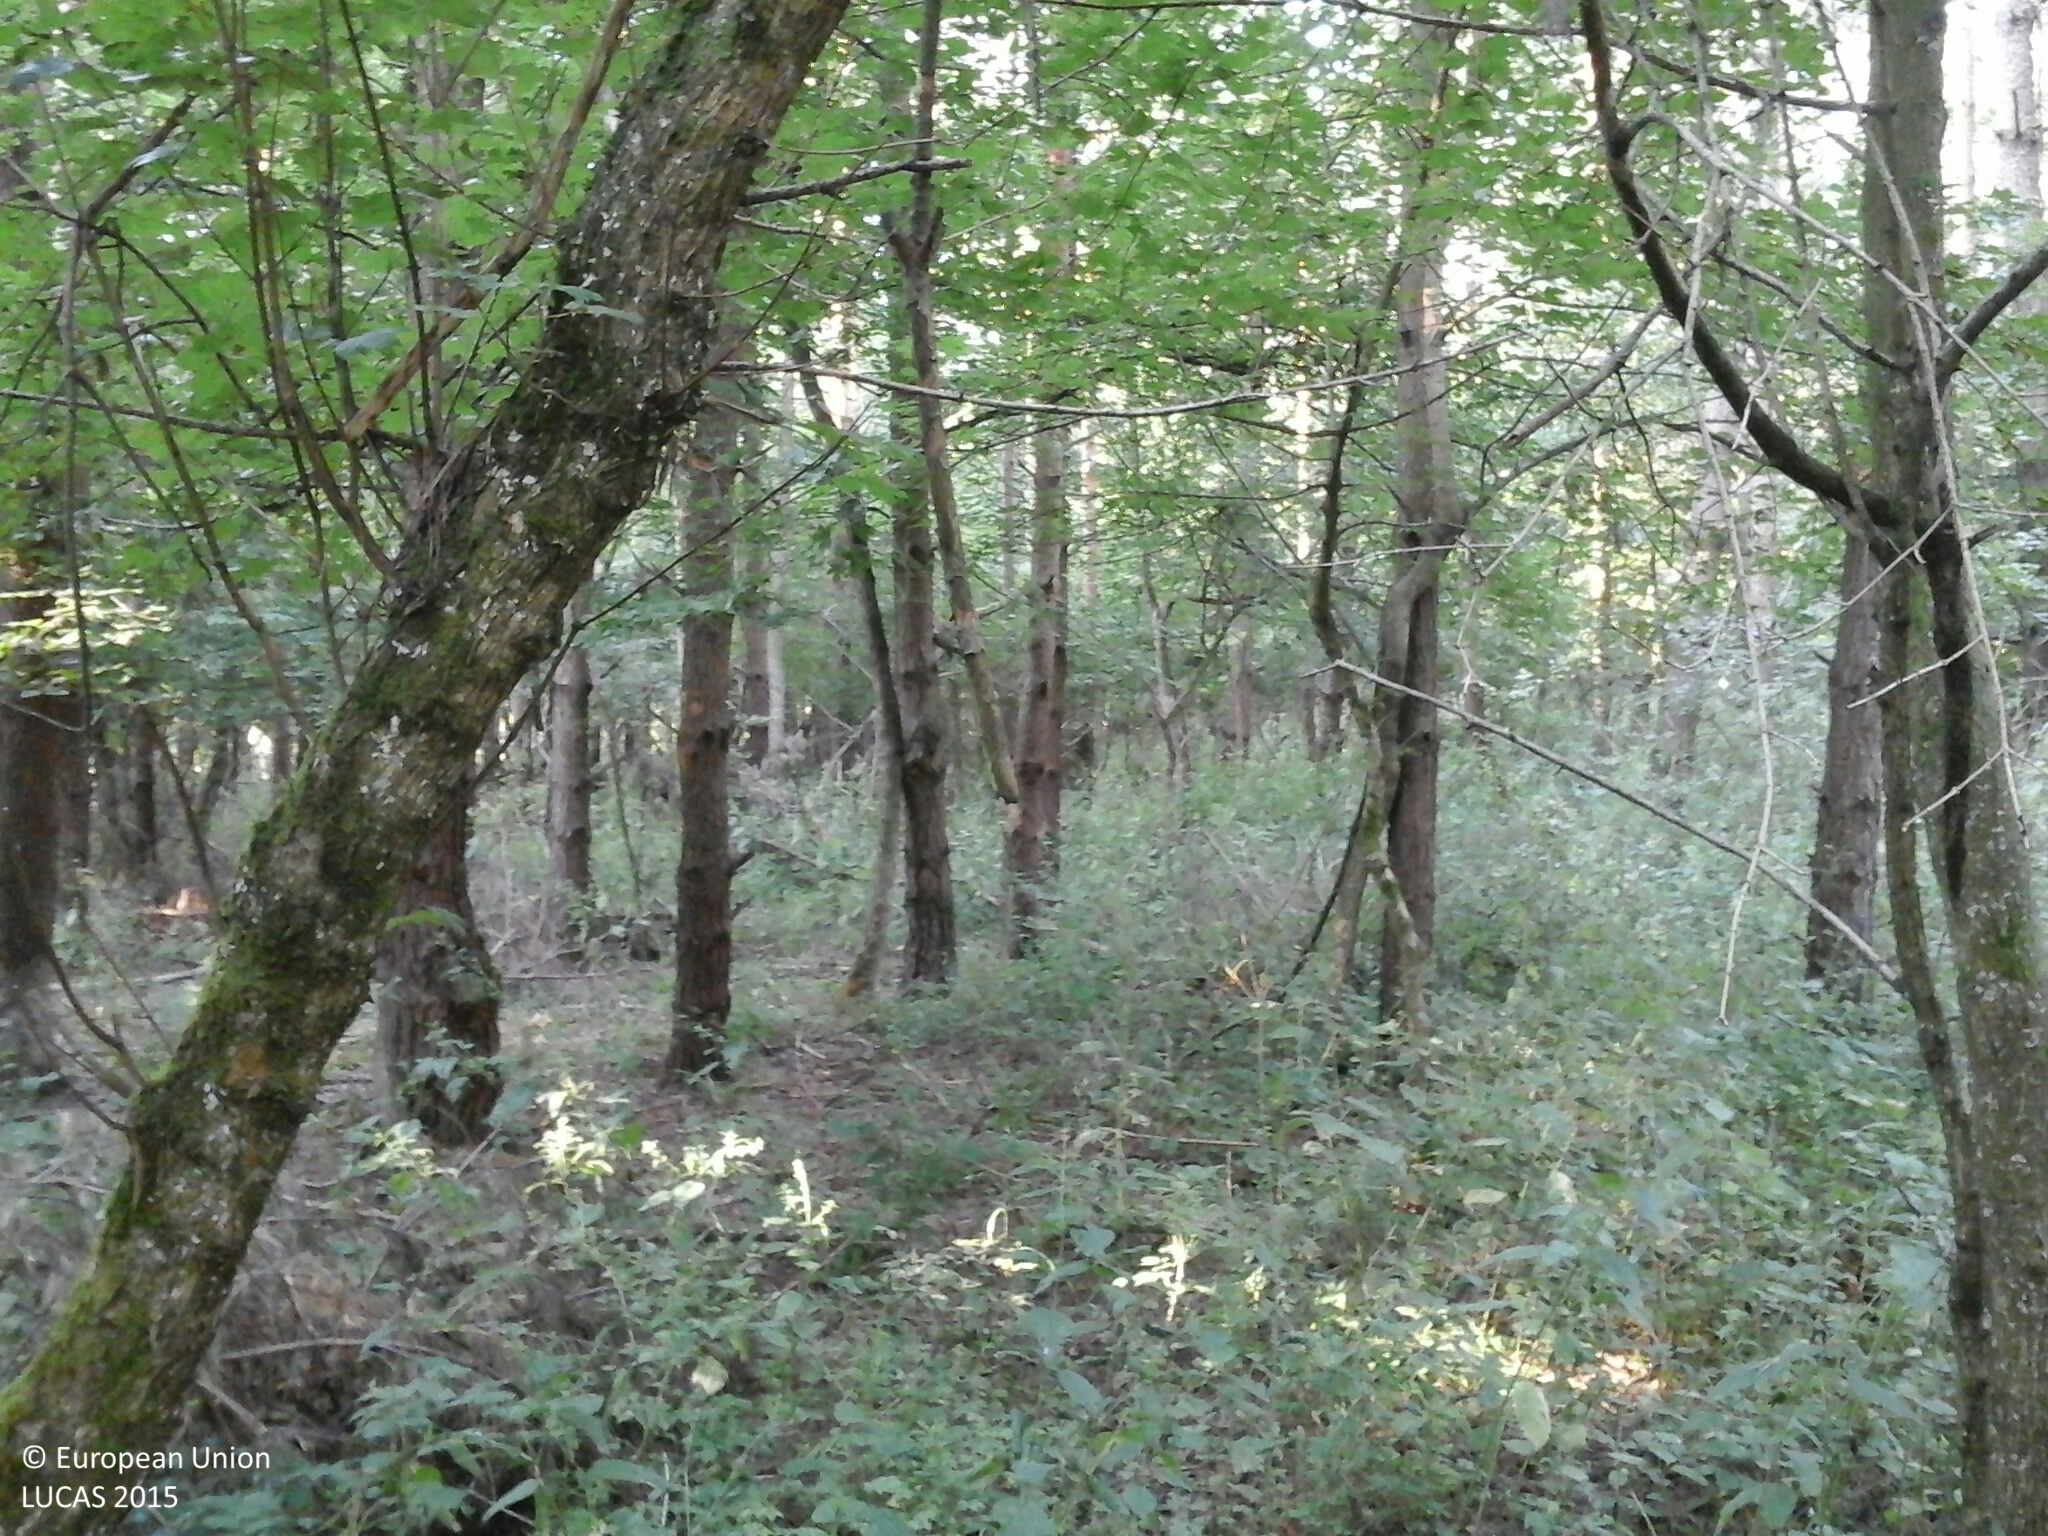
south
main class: Woodland
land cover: Pine dominated mixed woodland
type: hemiboreal forest and nemoral coniferous forest and mixed broadleaved-coniferous forest
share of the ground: > 75 %
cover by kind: coniferous forest trees 60 %, broadleaved forest trees 20 %, shrubs 15 %, herbaceous plants 5 %
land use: Forestry
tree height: > 5 m
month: August
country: HU
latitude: 47.1662
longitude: 16.4802
